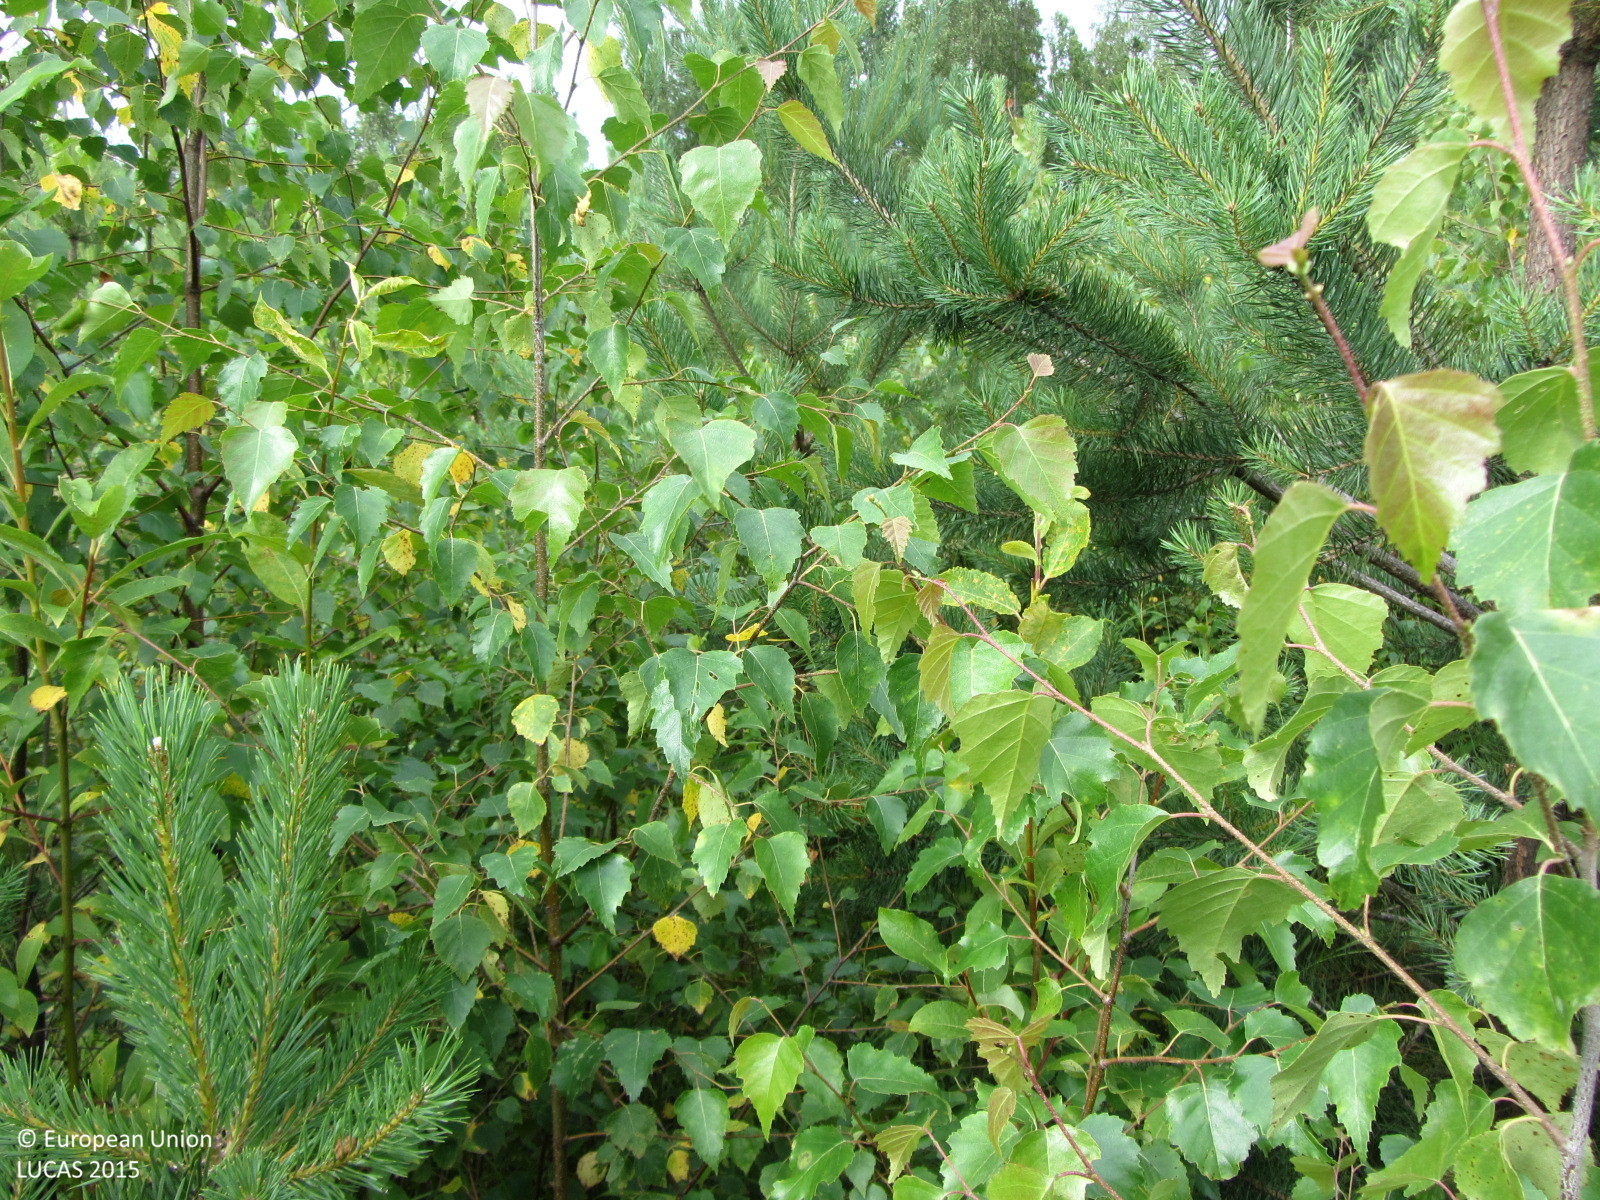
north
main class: Woodland
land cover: Pine dominated mixed woodland
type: boreal forest
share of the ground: > 75 %
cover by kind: broadleaved forest trees 55 %, coniferous forest trees 45 %
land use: Forestry
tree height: < 5 m
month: July
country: FI
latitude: 60.5148
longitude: 24.4392
